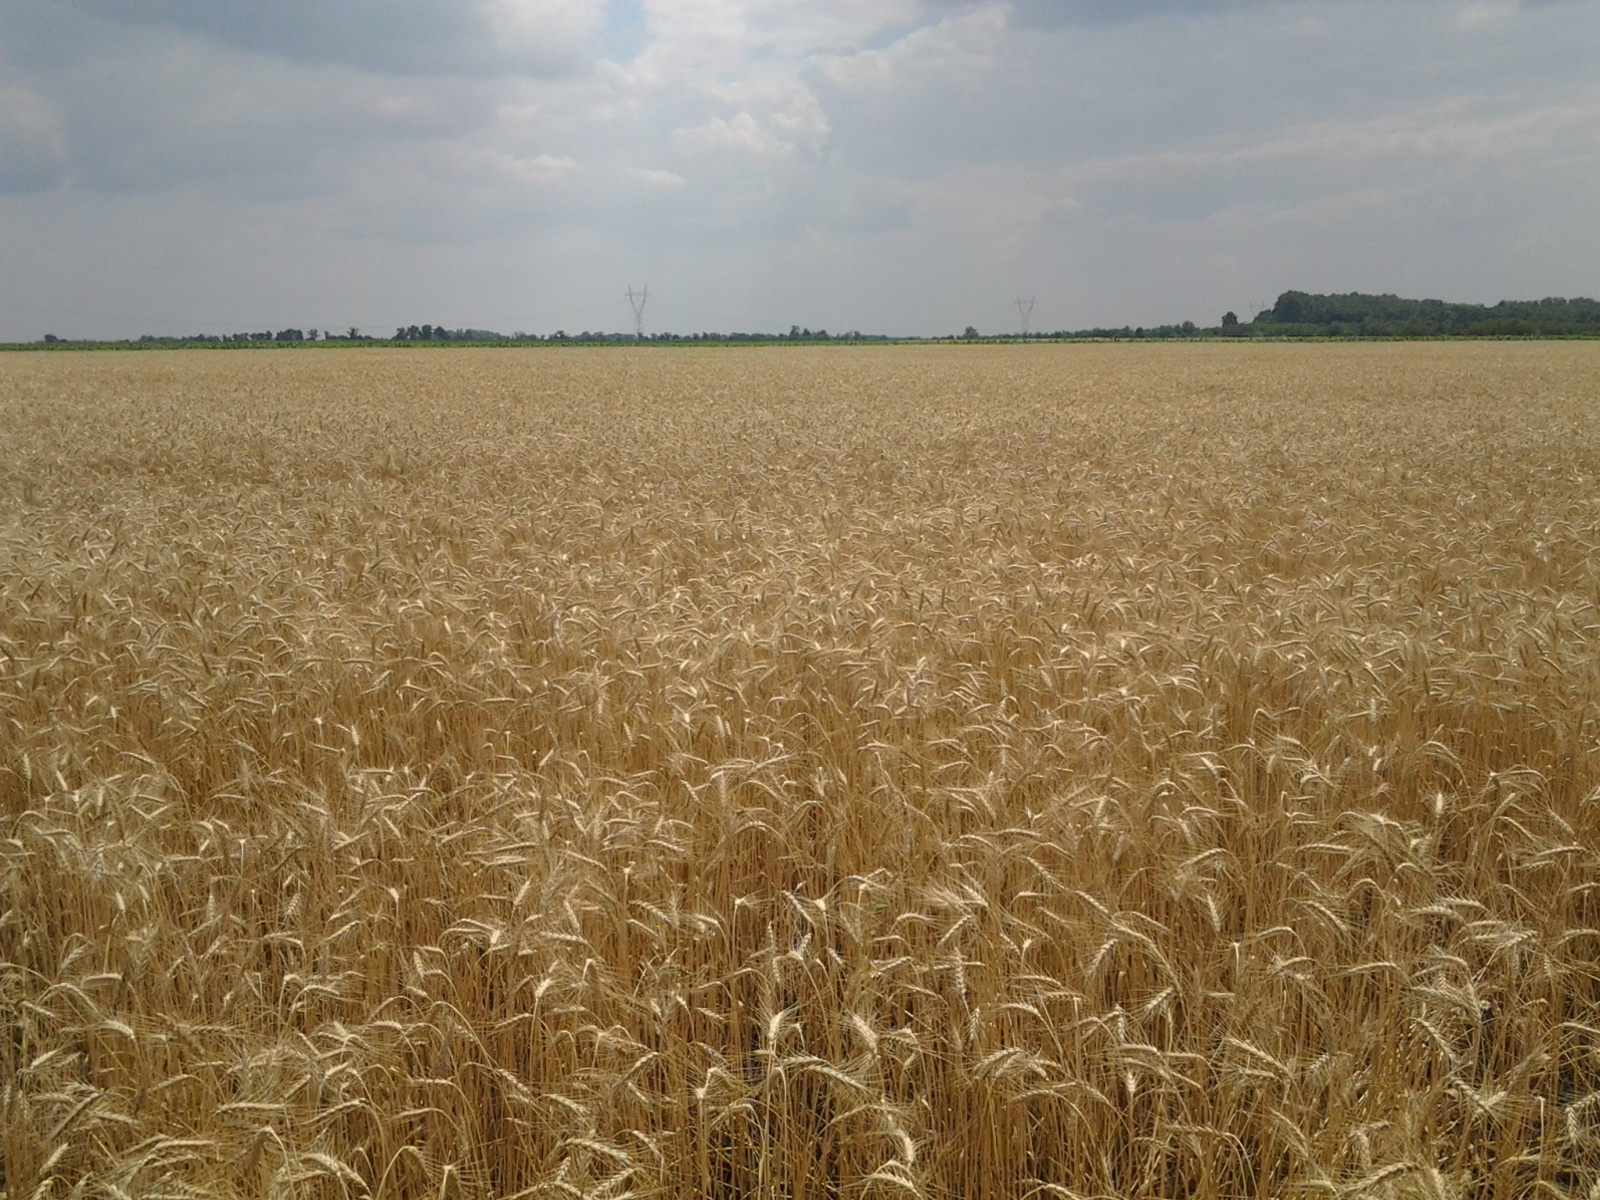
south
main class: Cropland
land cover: Triticale
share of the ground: > 75 %
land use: Agriculture (excluding fallow land and kitchen gardens)
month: June
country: HU
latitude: 47.4385
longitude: 20.2247
